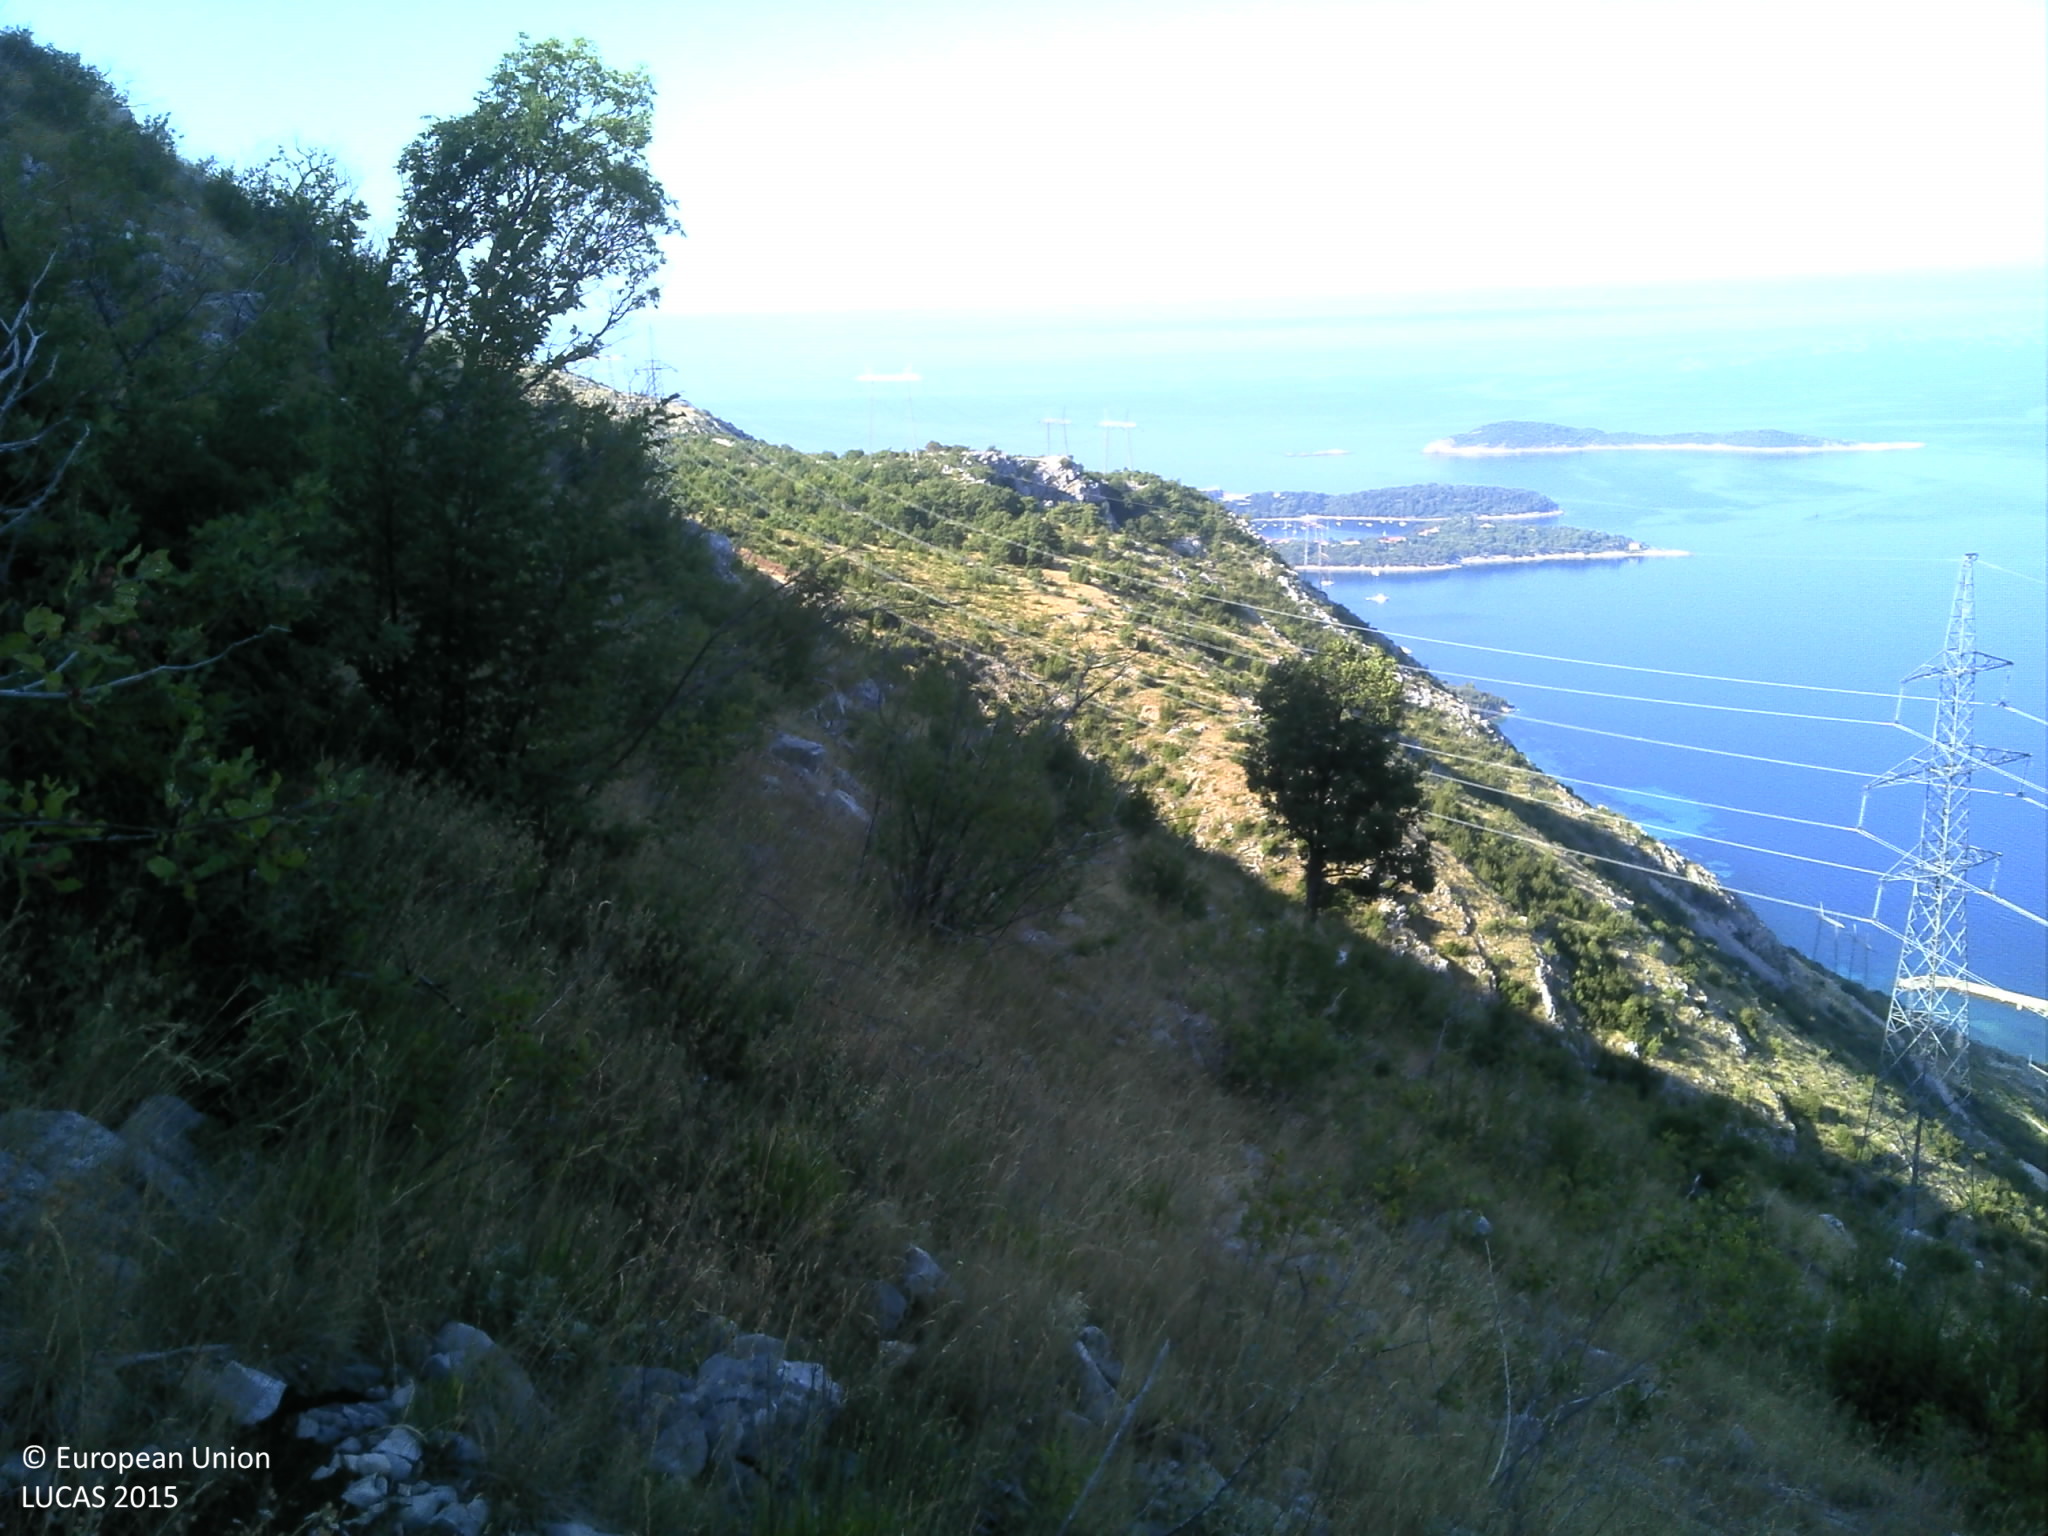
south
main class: Shrubland
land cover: Shrubland with sparse tree cover
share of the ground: 25 - 50 %
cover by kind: herbaceous plants 40 %, unconsolidated bare surface 30 %, shrubs 25 %, broadleaved forest trees 5 %
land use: Semi-natural and natural areas not in use
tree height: < 5 m
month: July
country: HR
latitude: 42.6079
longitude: 18.2428
